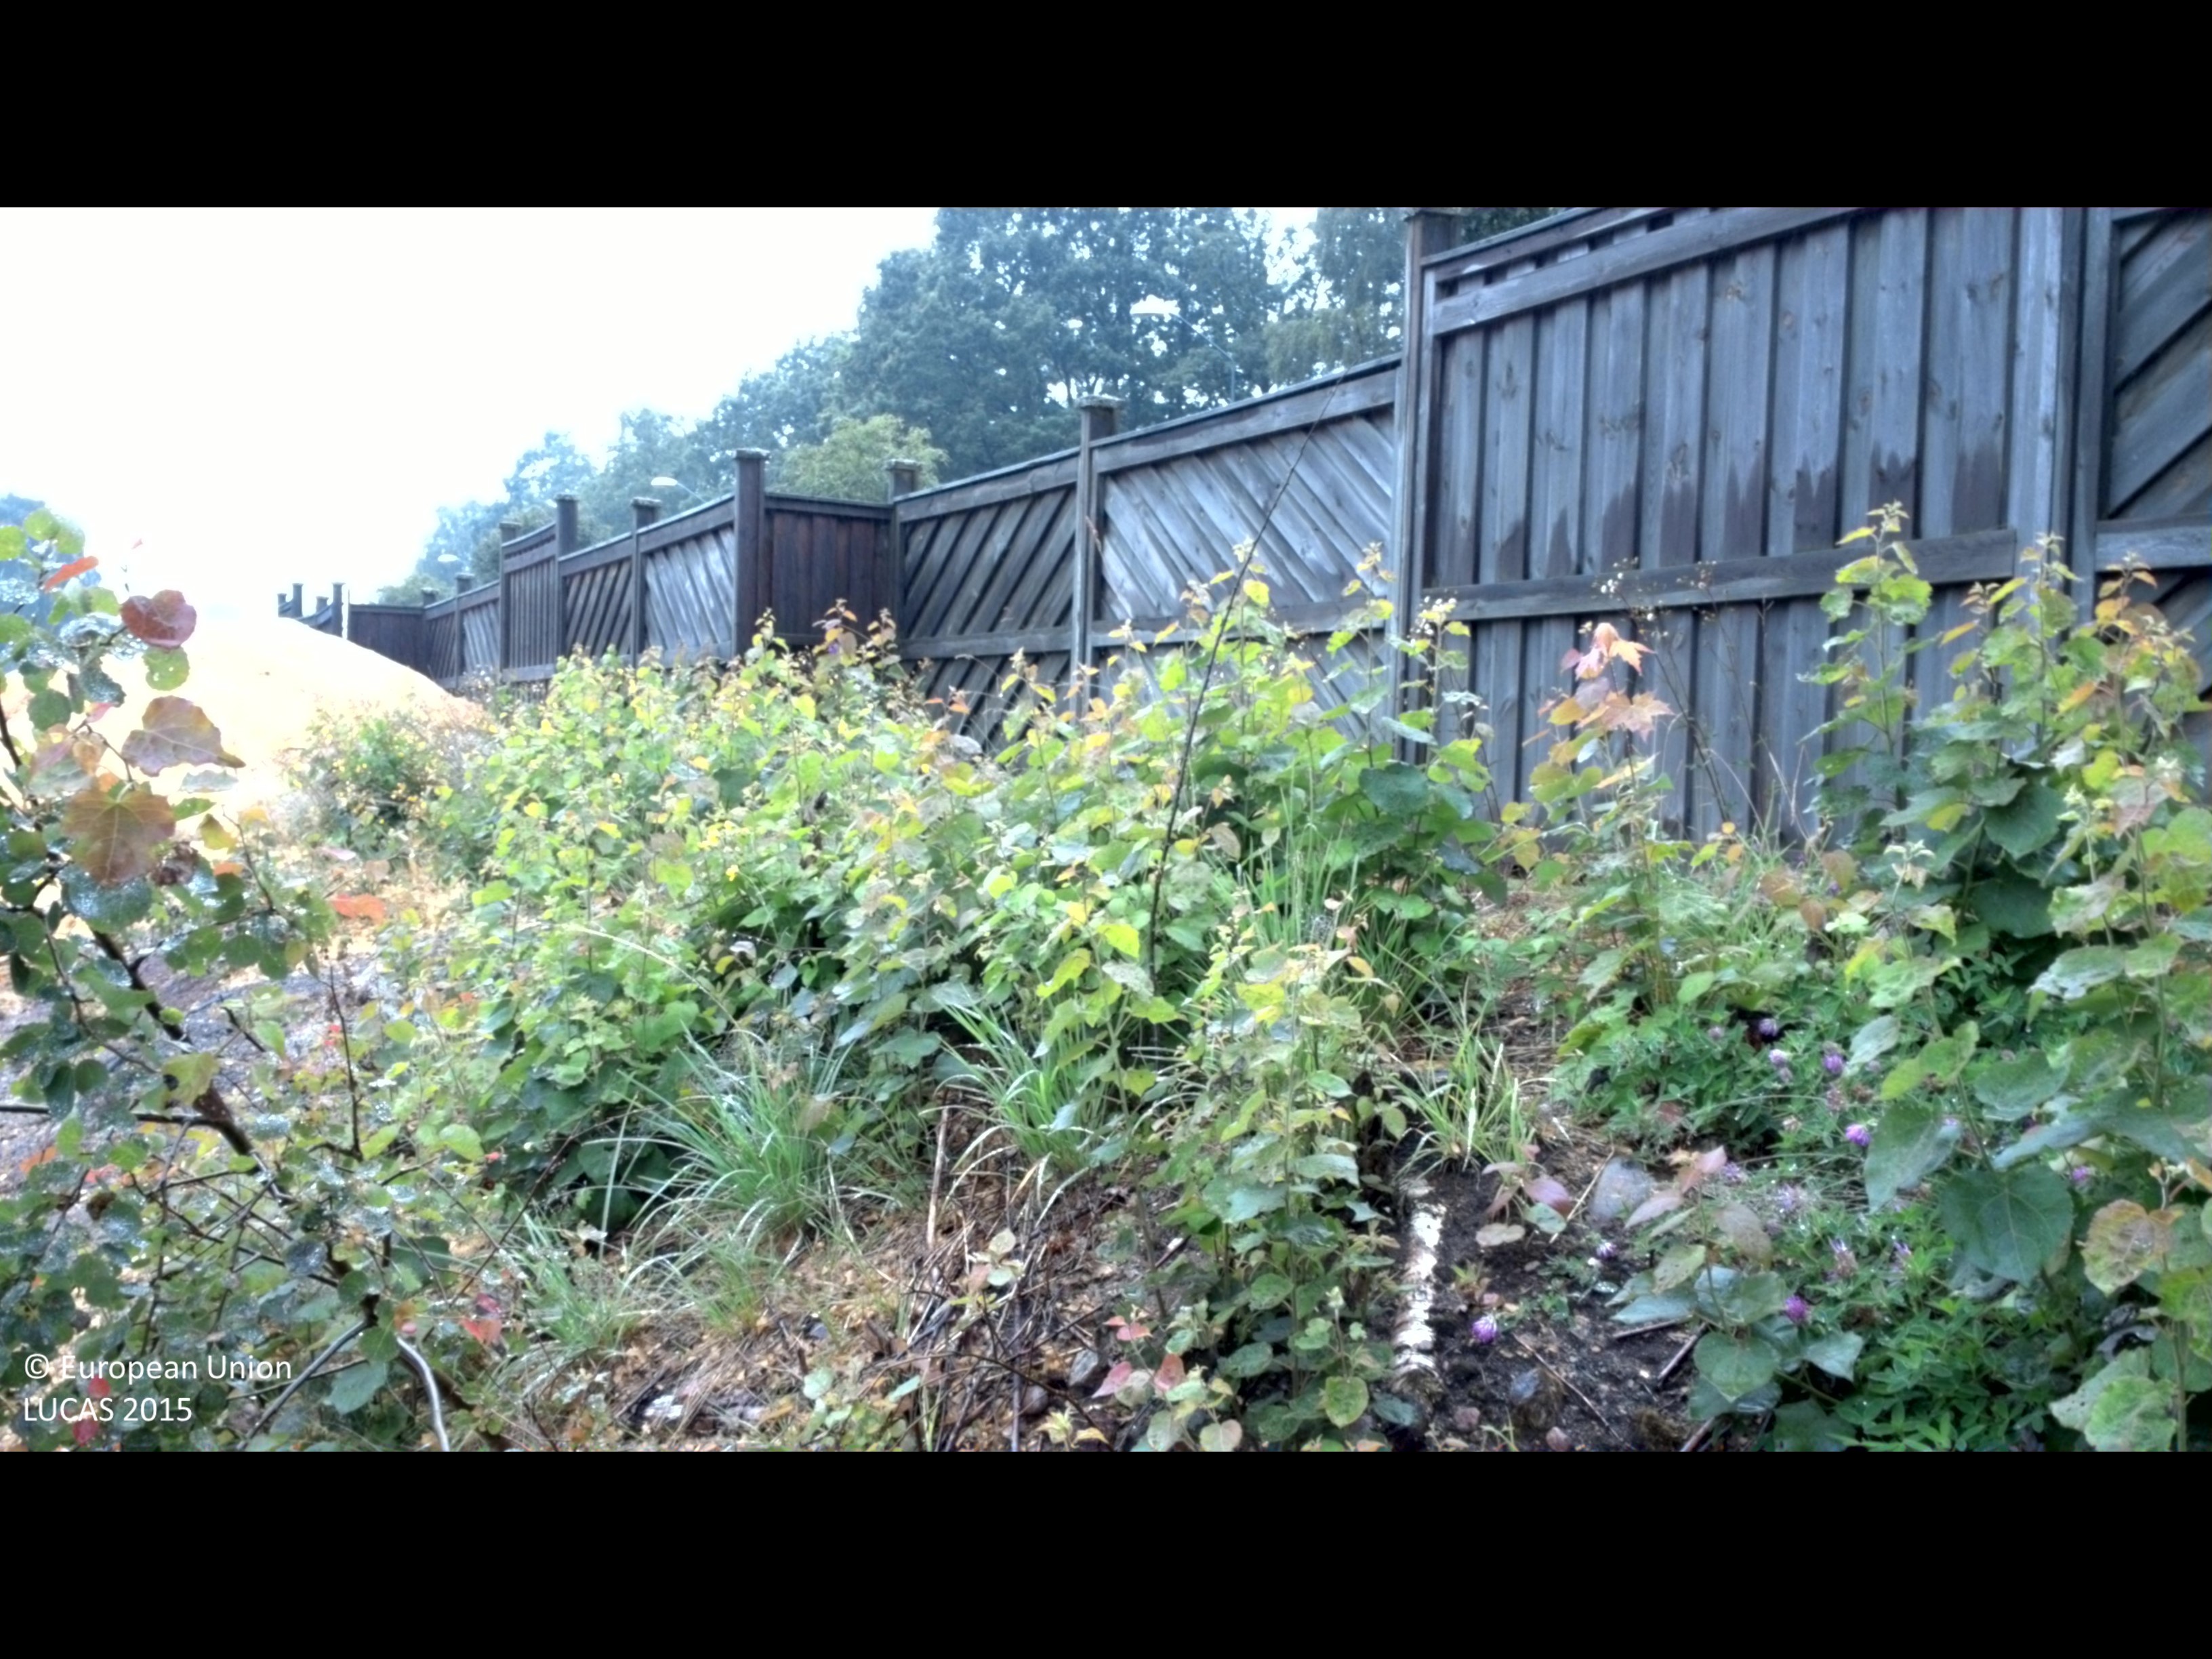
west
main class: Woodland
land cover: Broadleaved woodland
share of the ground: 25 - 50 %
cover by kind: broadleaved forest trees 50 %, herbaceous plants 20 %, lichens and mosses 20 %, unconsolidated bare surface 10 %
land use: Semi-natural and natural areas not in use
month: July
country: SE
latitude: 56.5828
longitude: 13.7578
